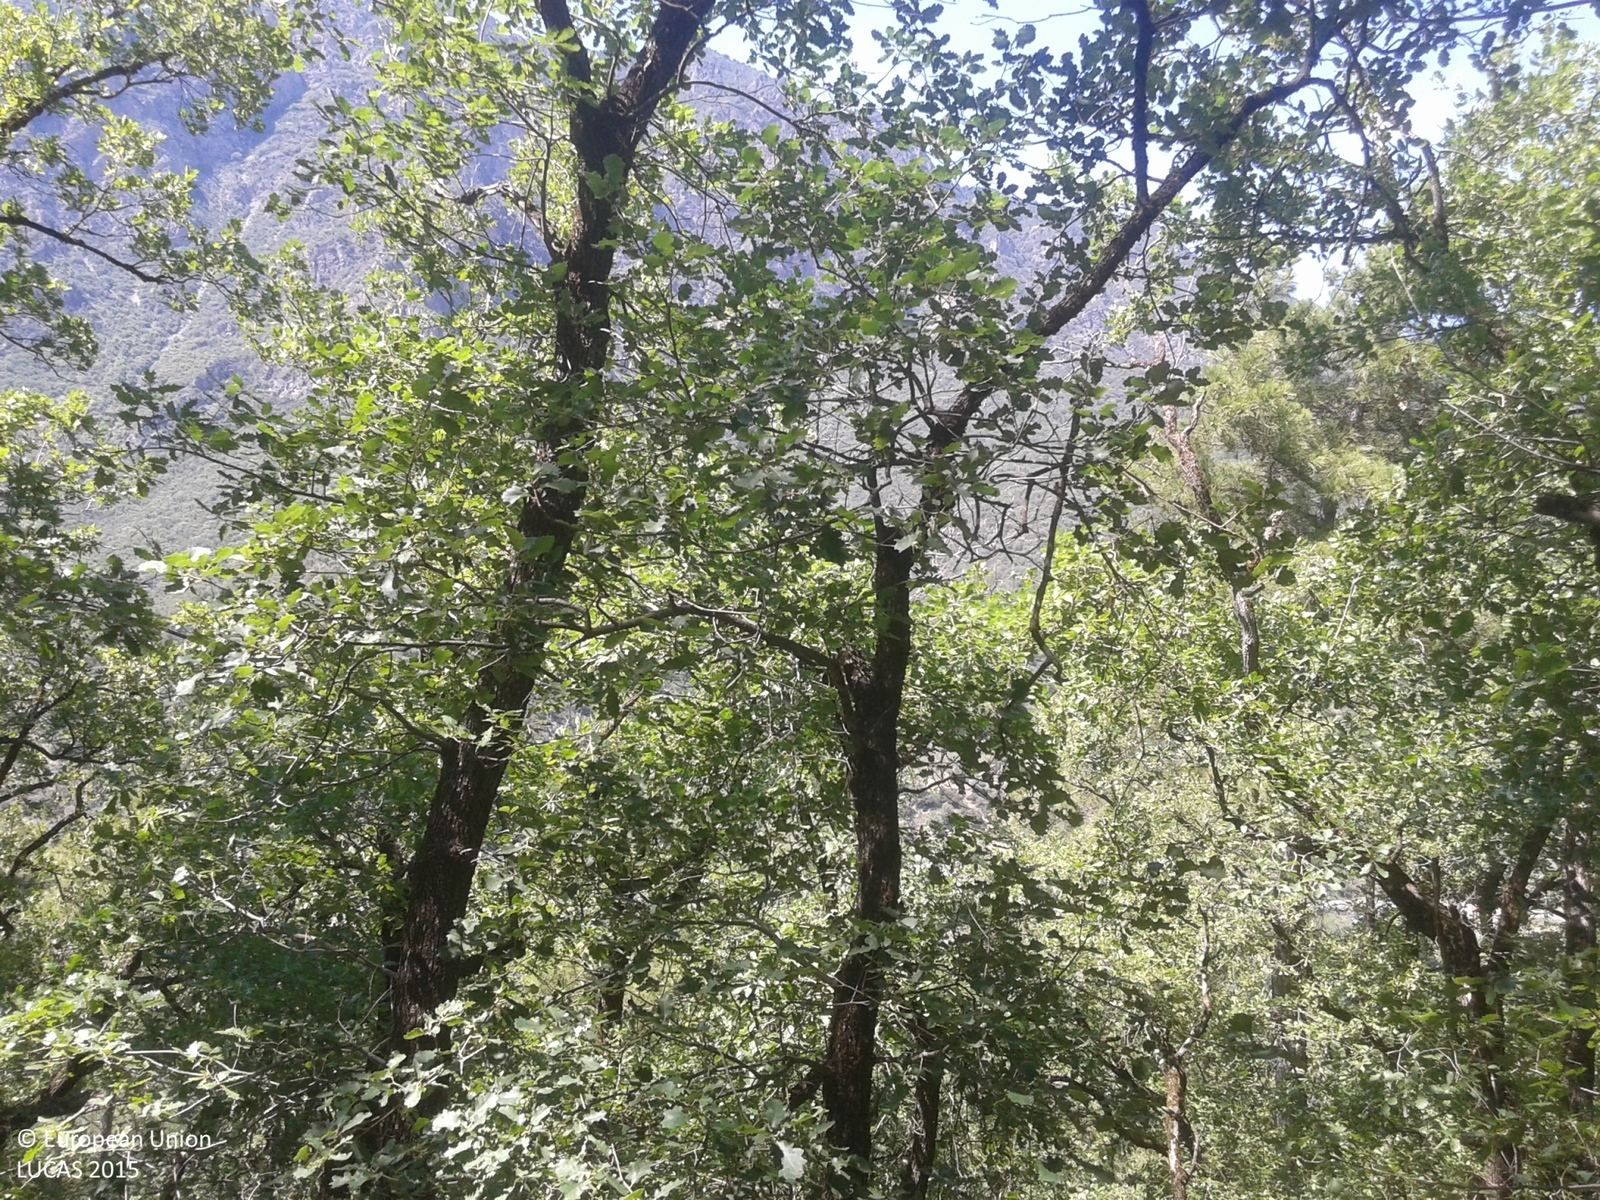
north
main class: Woodland
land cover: Other mixed woodland
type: coniferous forest of the mediterranean region
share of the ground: > 75 %
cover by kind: broadleaved forest trees 55 %, coniferous forest trees 35 %, herbaceous plants 5 %, lichens and mosses 5 %
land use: Semi-natural and natural areas not in use
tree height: > 5 m
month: June
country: ES
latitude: 42.3567
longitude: 1.5725
